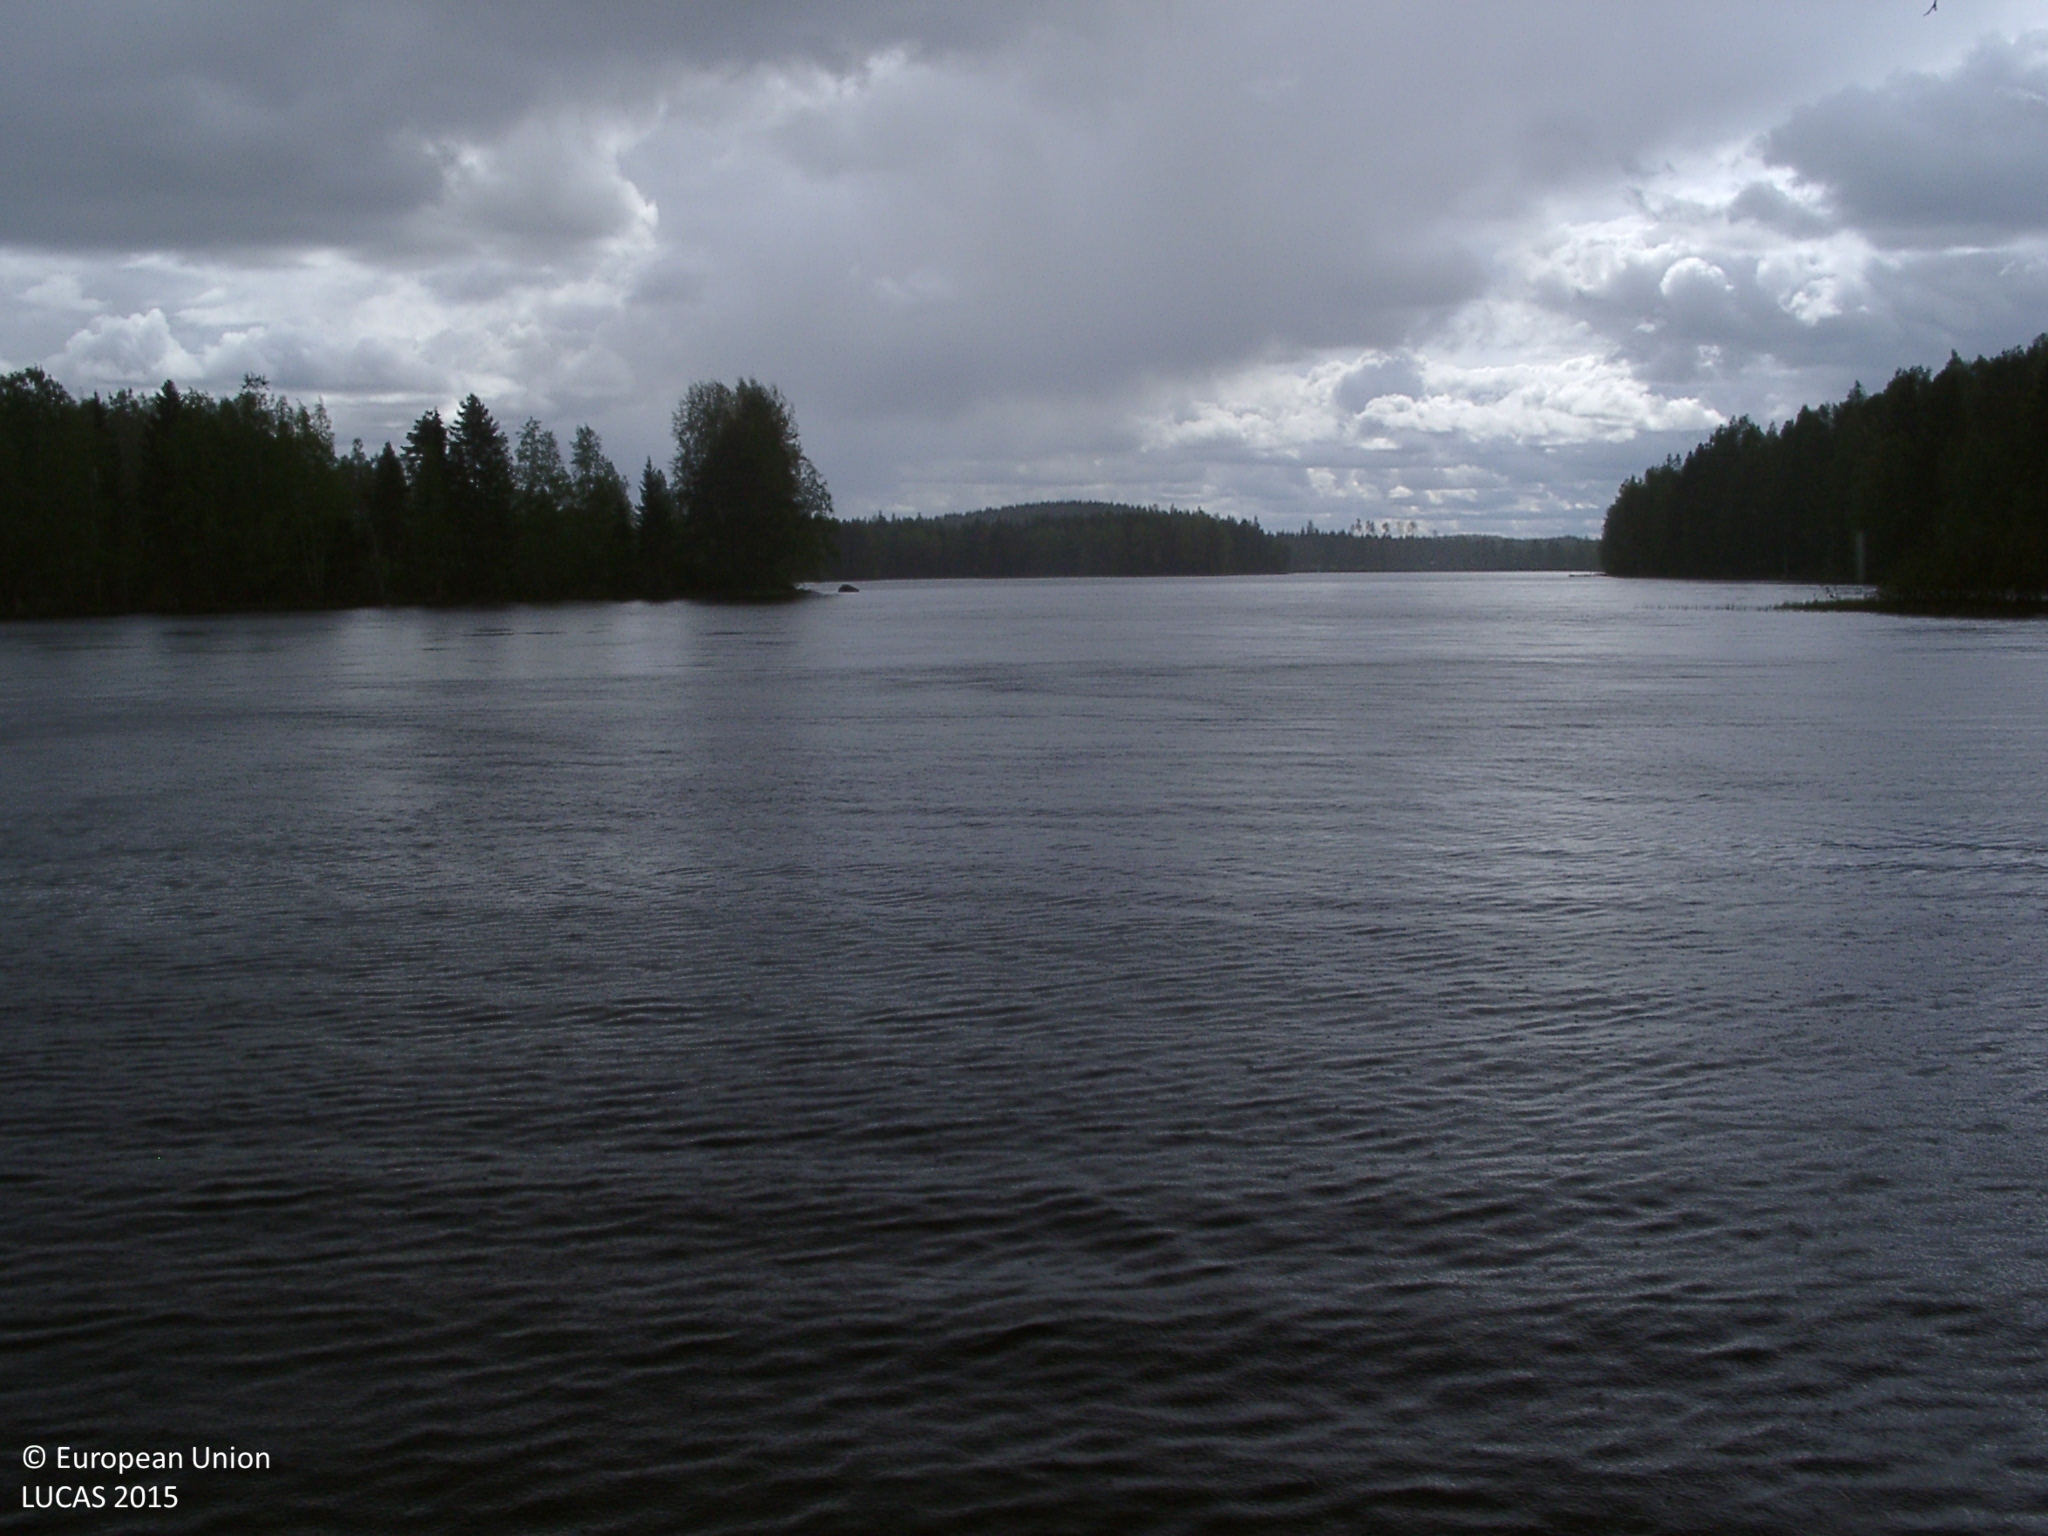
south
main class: Woodland
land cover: Other mixed woodland
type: boreal forest
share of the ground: 50 - 75 %
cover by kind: coniferous forest trees 35 %, shrubs 35 %, broadleaved forest trees 25 %, herbaceous plants 5 %
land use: Amenities, museums, leisure
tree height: > 5 m
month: June
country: FI
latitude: 62.2106
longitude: 25.4761
